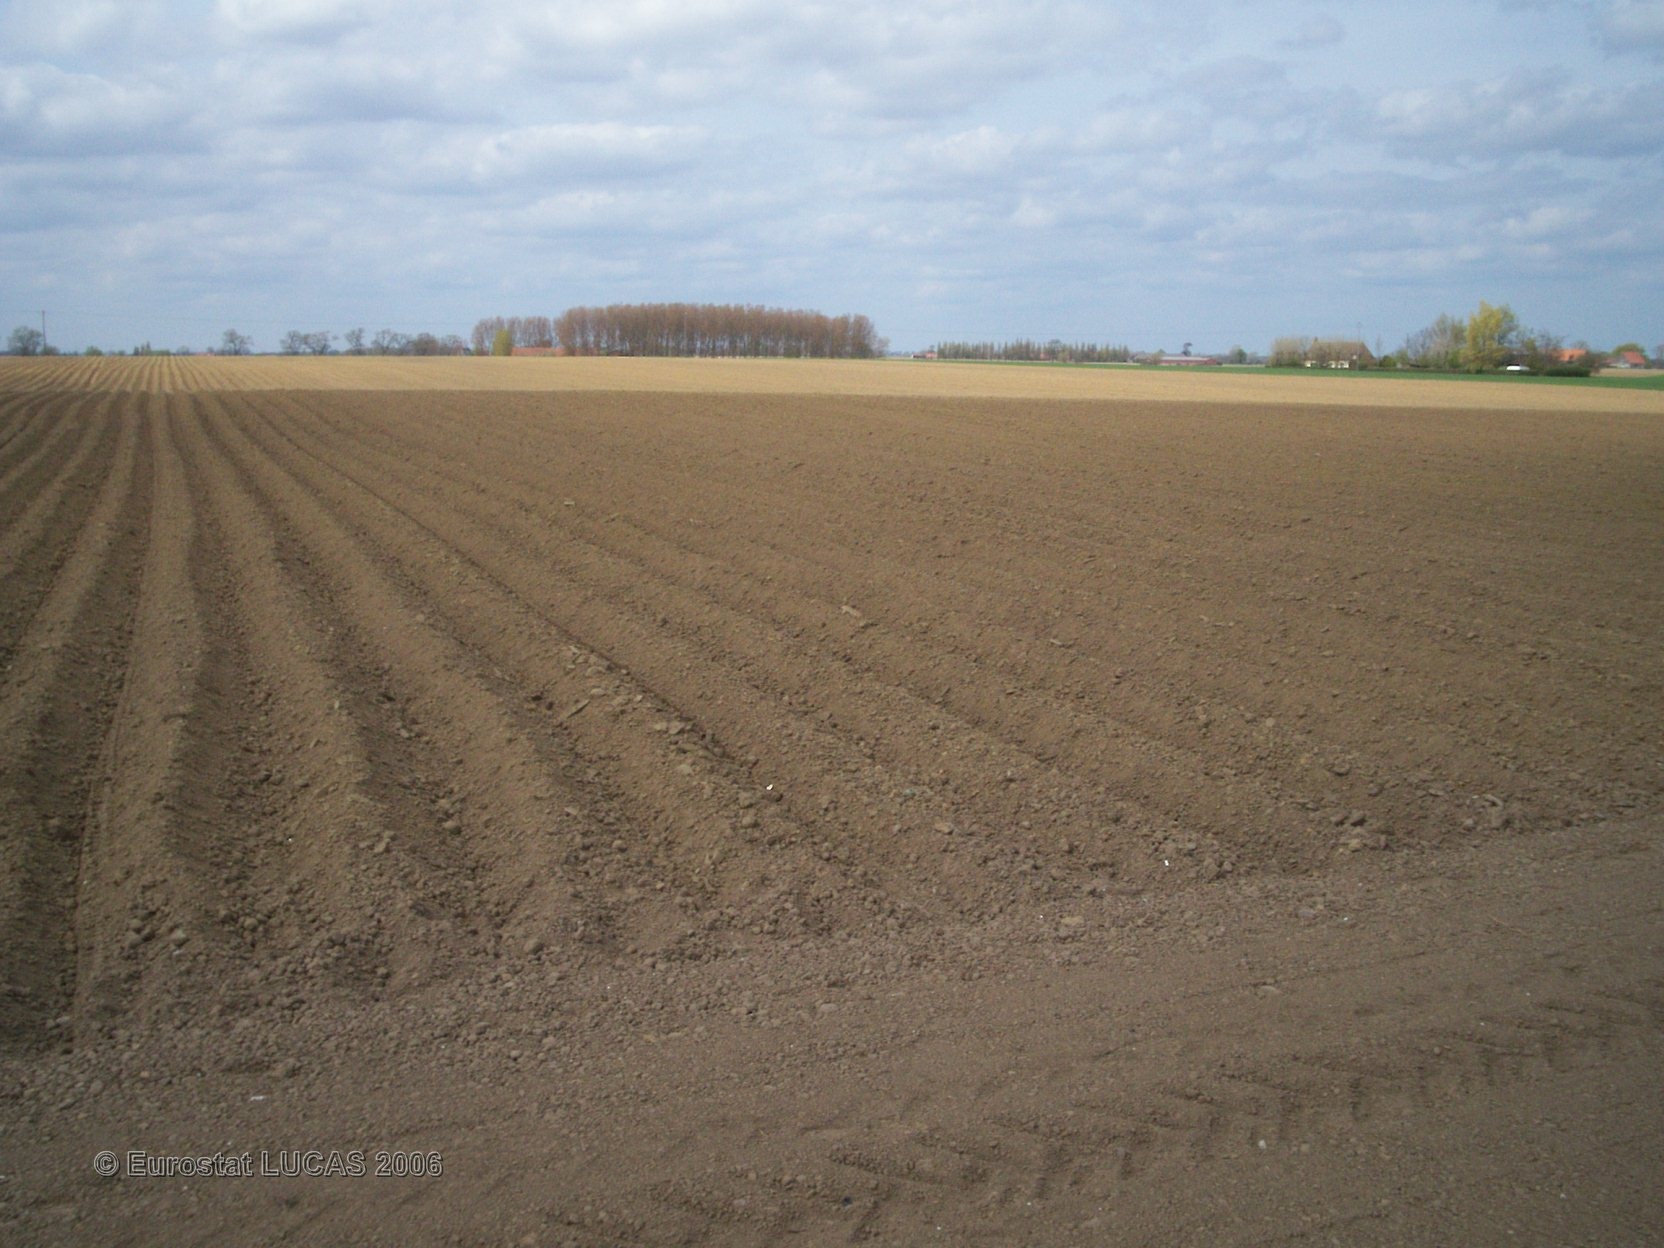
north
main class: Cropland
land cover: Other fresh vegetables
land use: Agriculture (excluding fallow land and kitchen gardens)
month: June
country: FR
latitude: 50.8618
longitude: 2.5571
